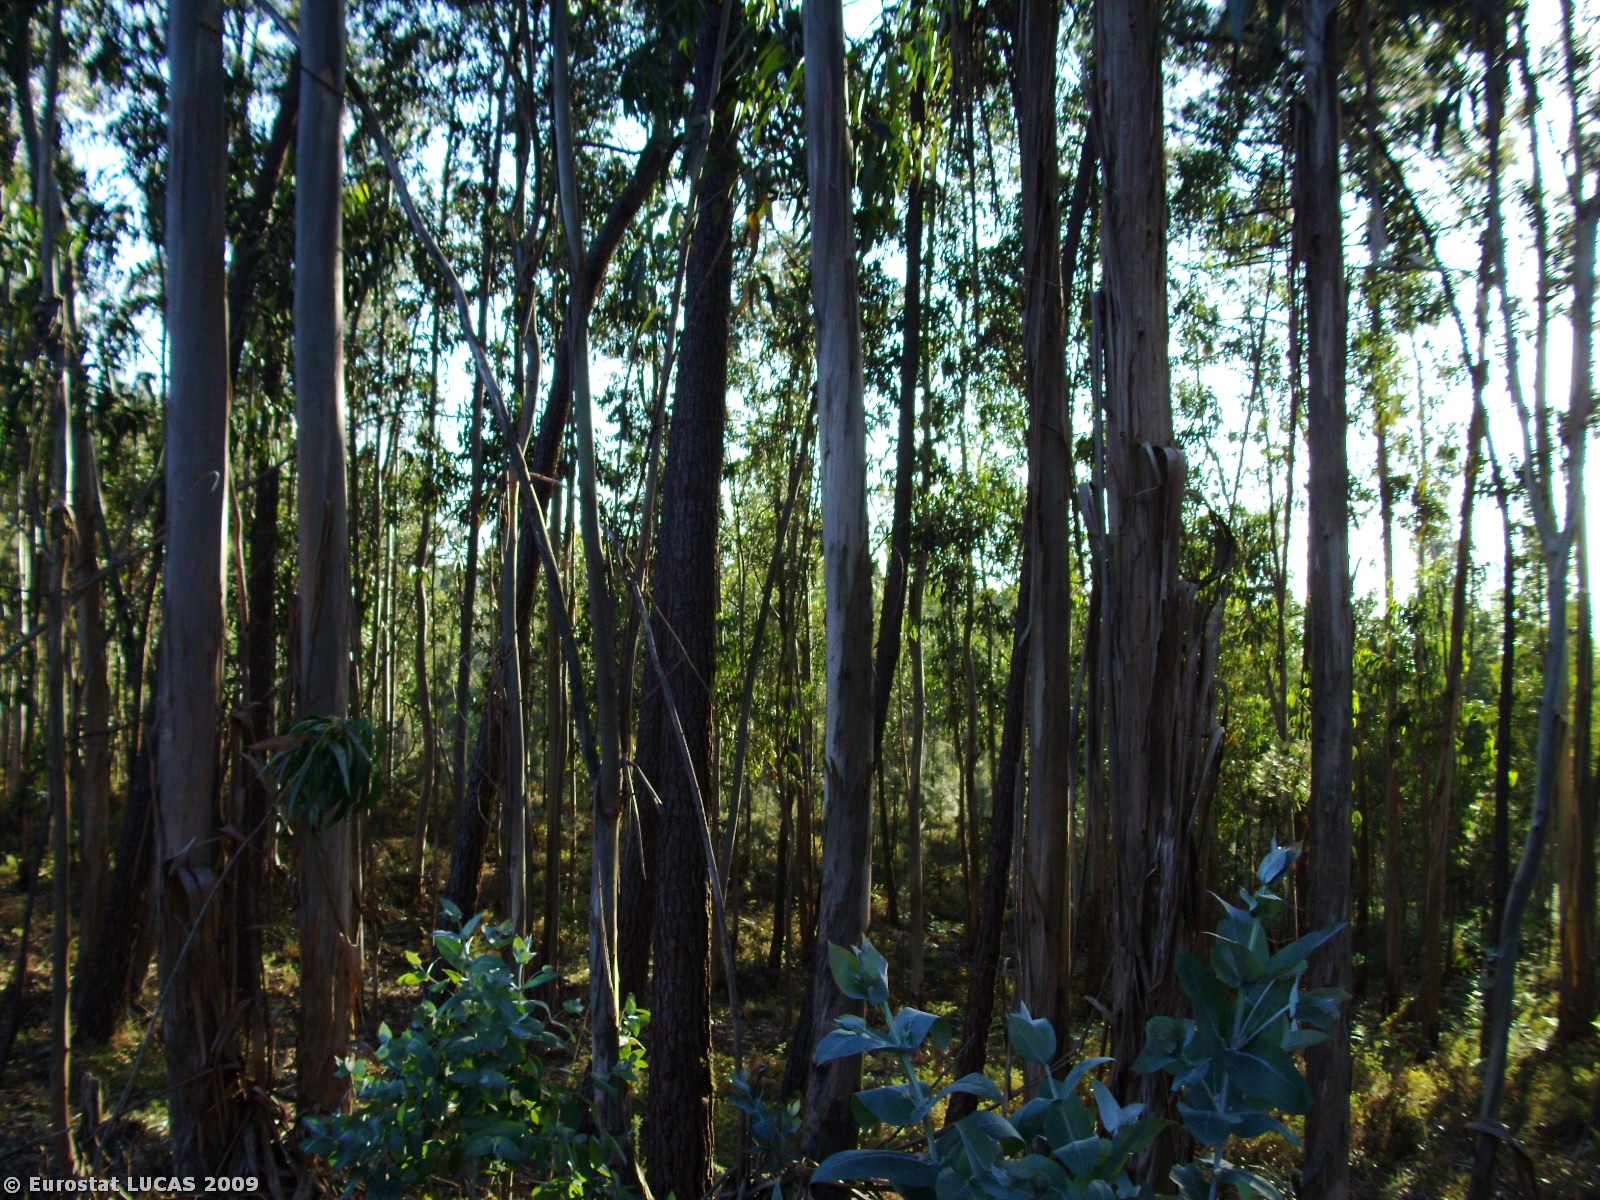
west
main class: Woodland
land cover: Broadleaved woodland
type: plantations and self-sown exotic forest
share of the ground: > 75 %
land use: Forestry
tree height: > 5 m
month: May
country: PT
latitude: 40.6183
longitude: -8.3999
